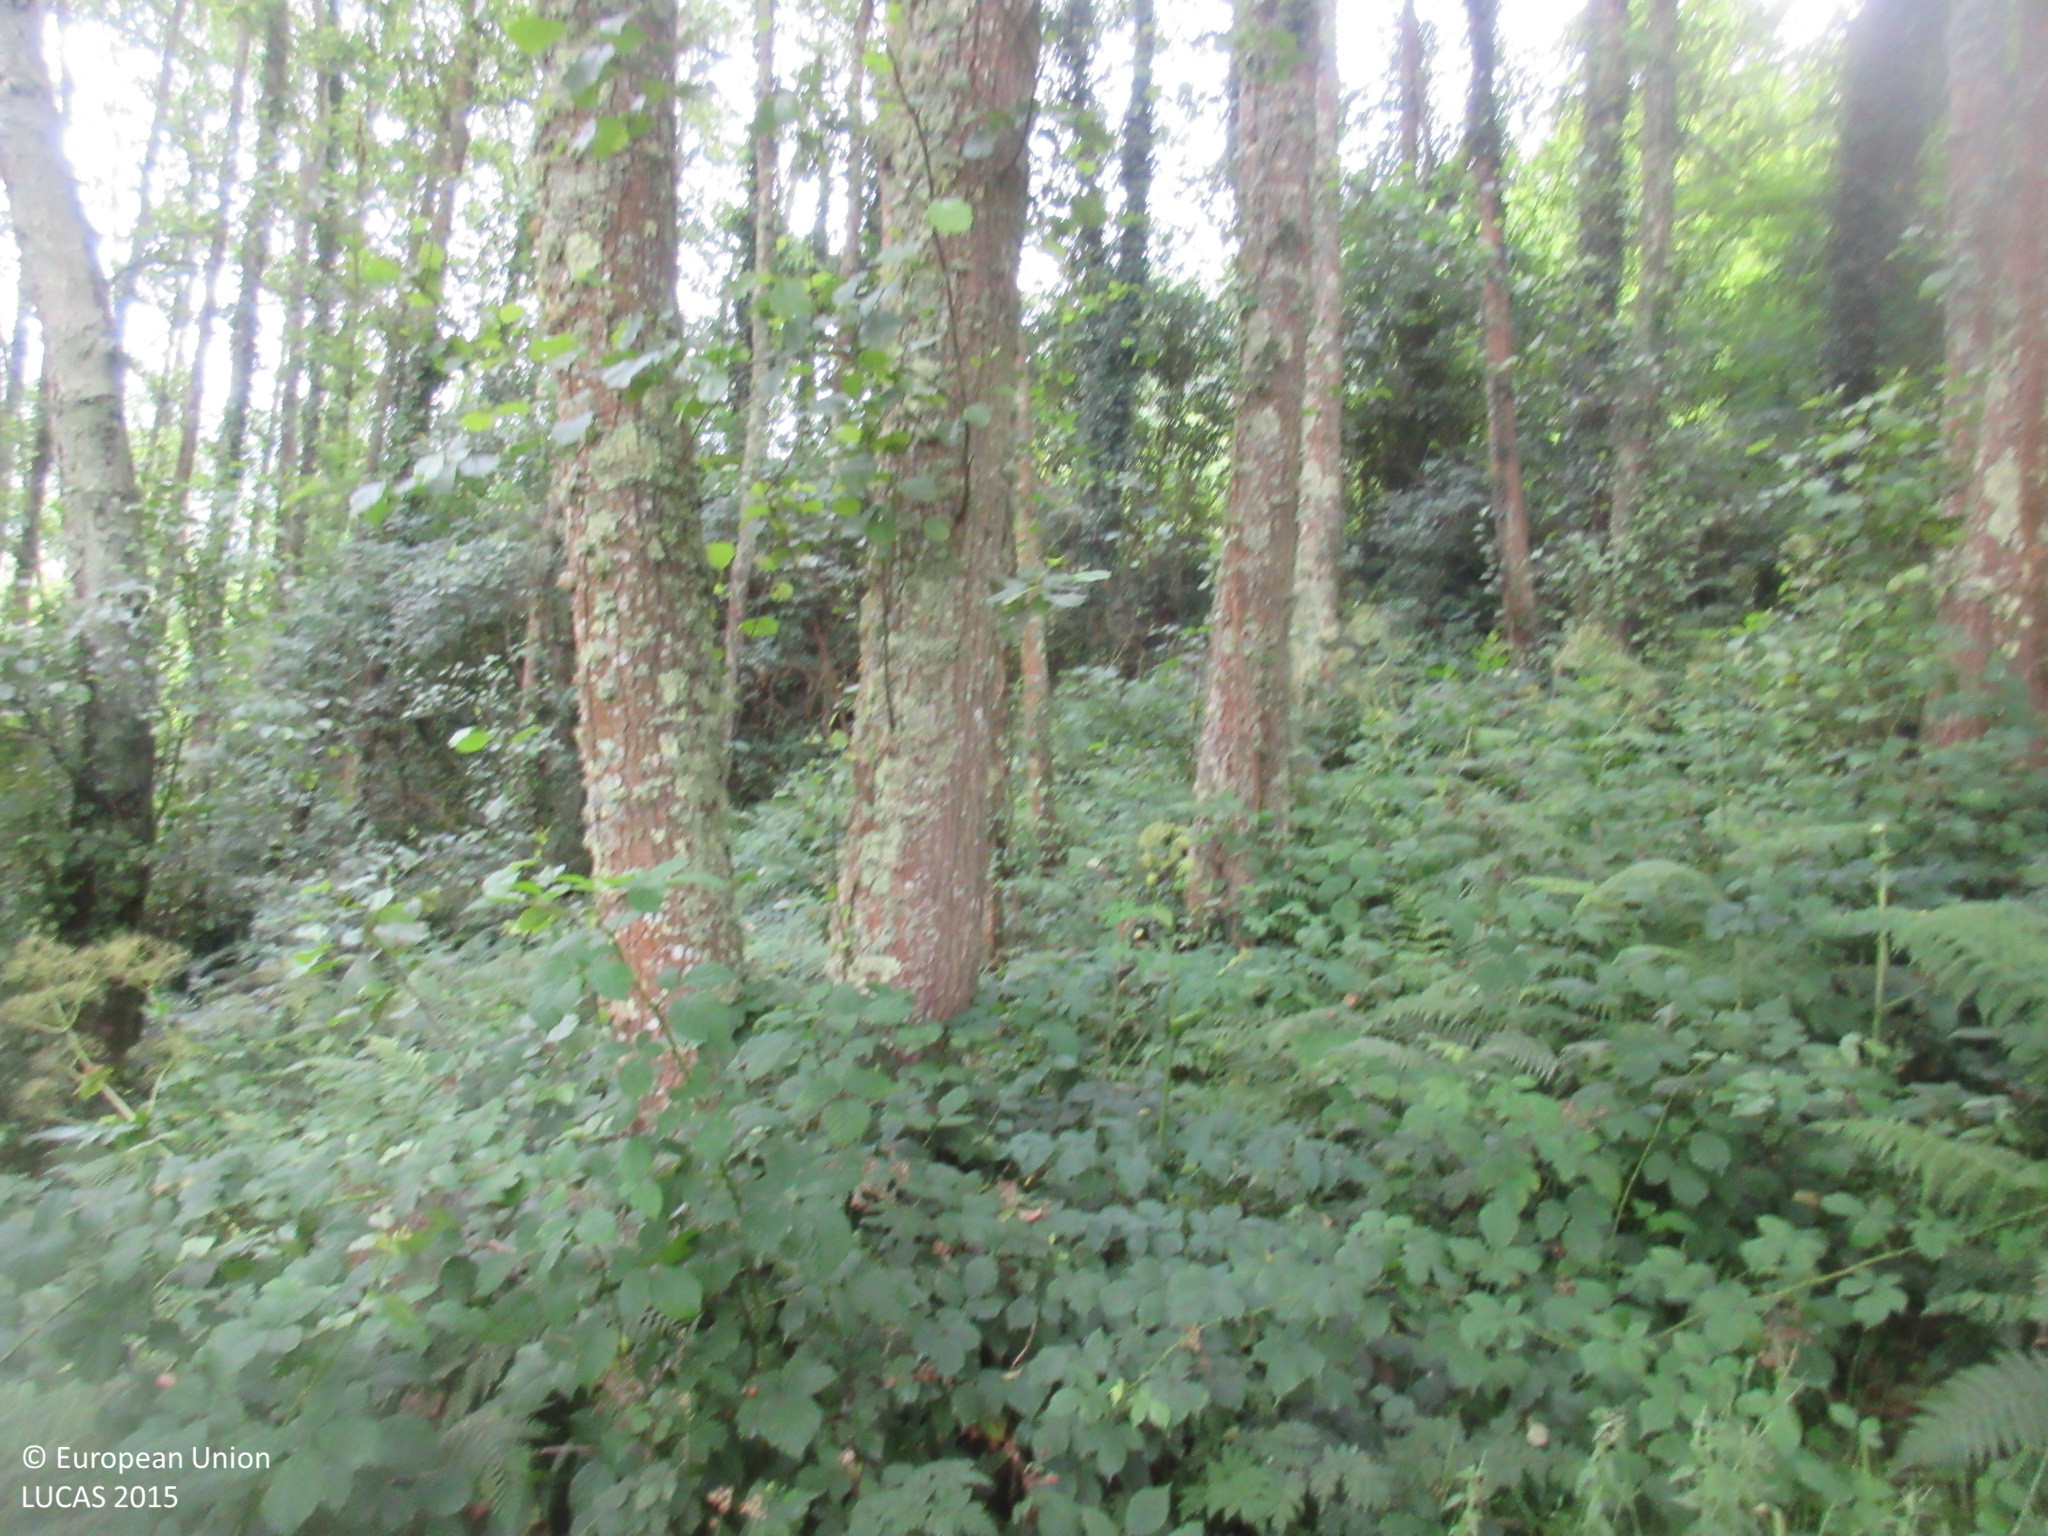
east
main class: Grassland
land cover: Grassland without tree/shrub cover
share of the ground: > 75 %
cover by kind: herbaceous plants 100 %
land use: Agriculture (excluding fallow land and kitchen gardens)
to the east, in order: Grassland without tree/shrub cover; Grassland with sparse tree/shrub cover; Grassland without tree/shrub cover; Broadleaved woodland
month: July
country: ES
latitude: 43.4338
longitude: -6.3203
